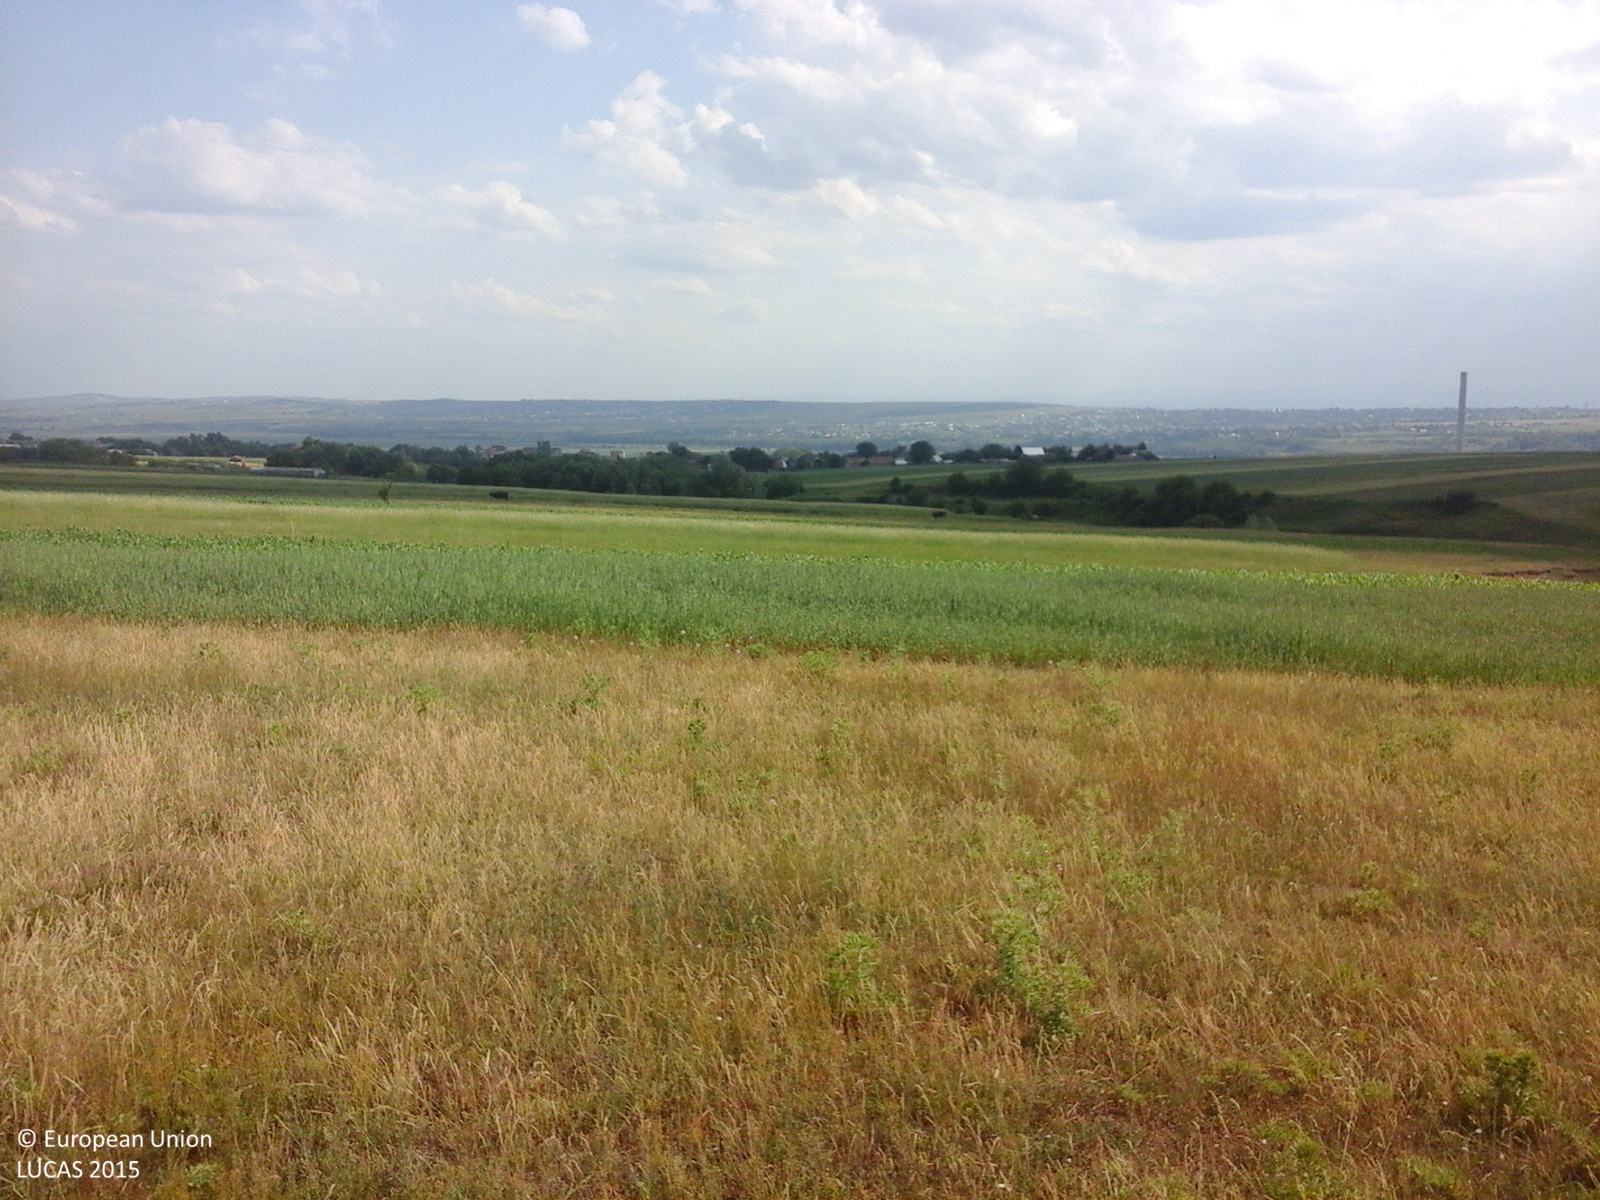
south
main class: Grassland
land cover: Grassland without tree/shrub cover
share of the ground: > 75 %
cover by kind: herbaceous plants 100 %
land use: Agriculture (excluding fallow land and kitchen gardens)
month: June
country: RO
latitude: 47.6754
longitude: 26.3216
